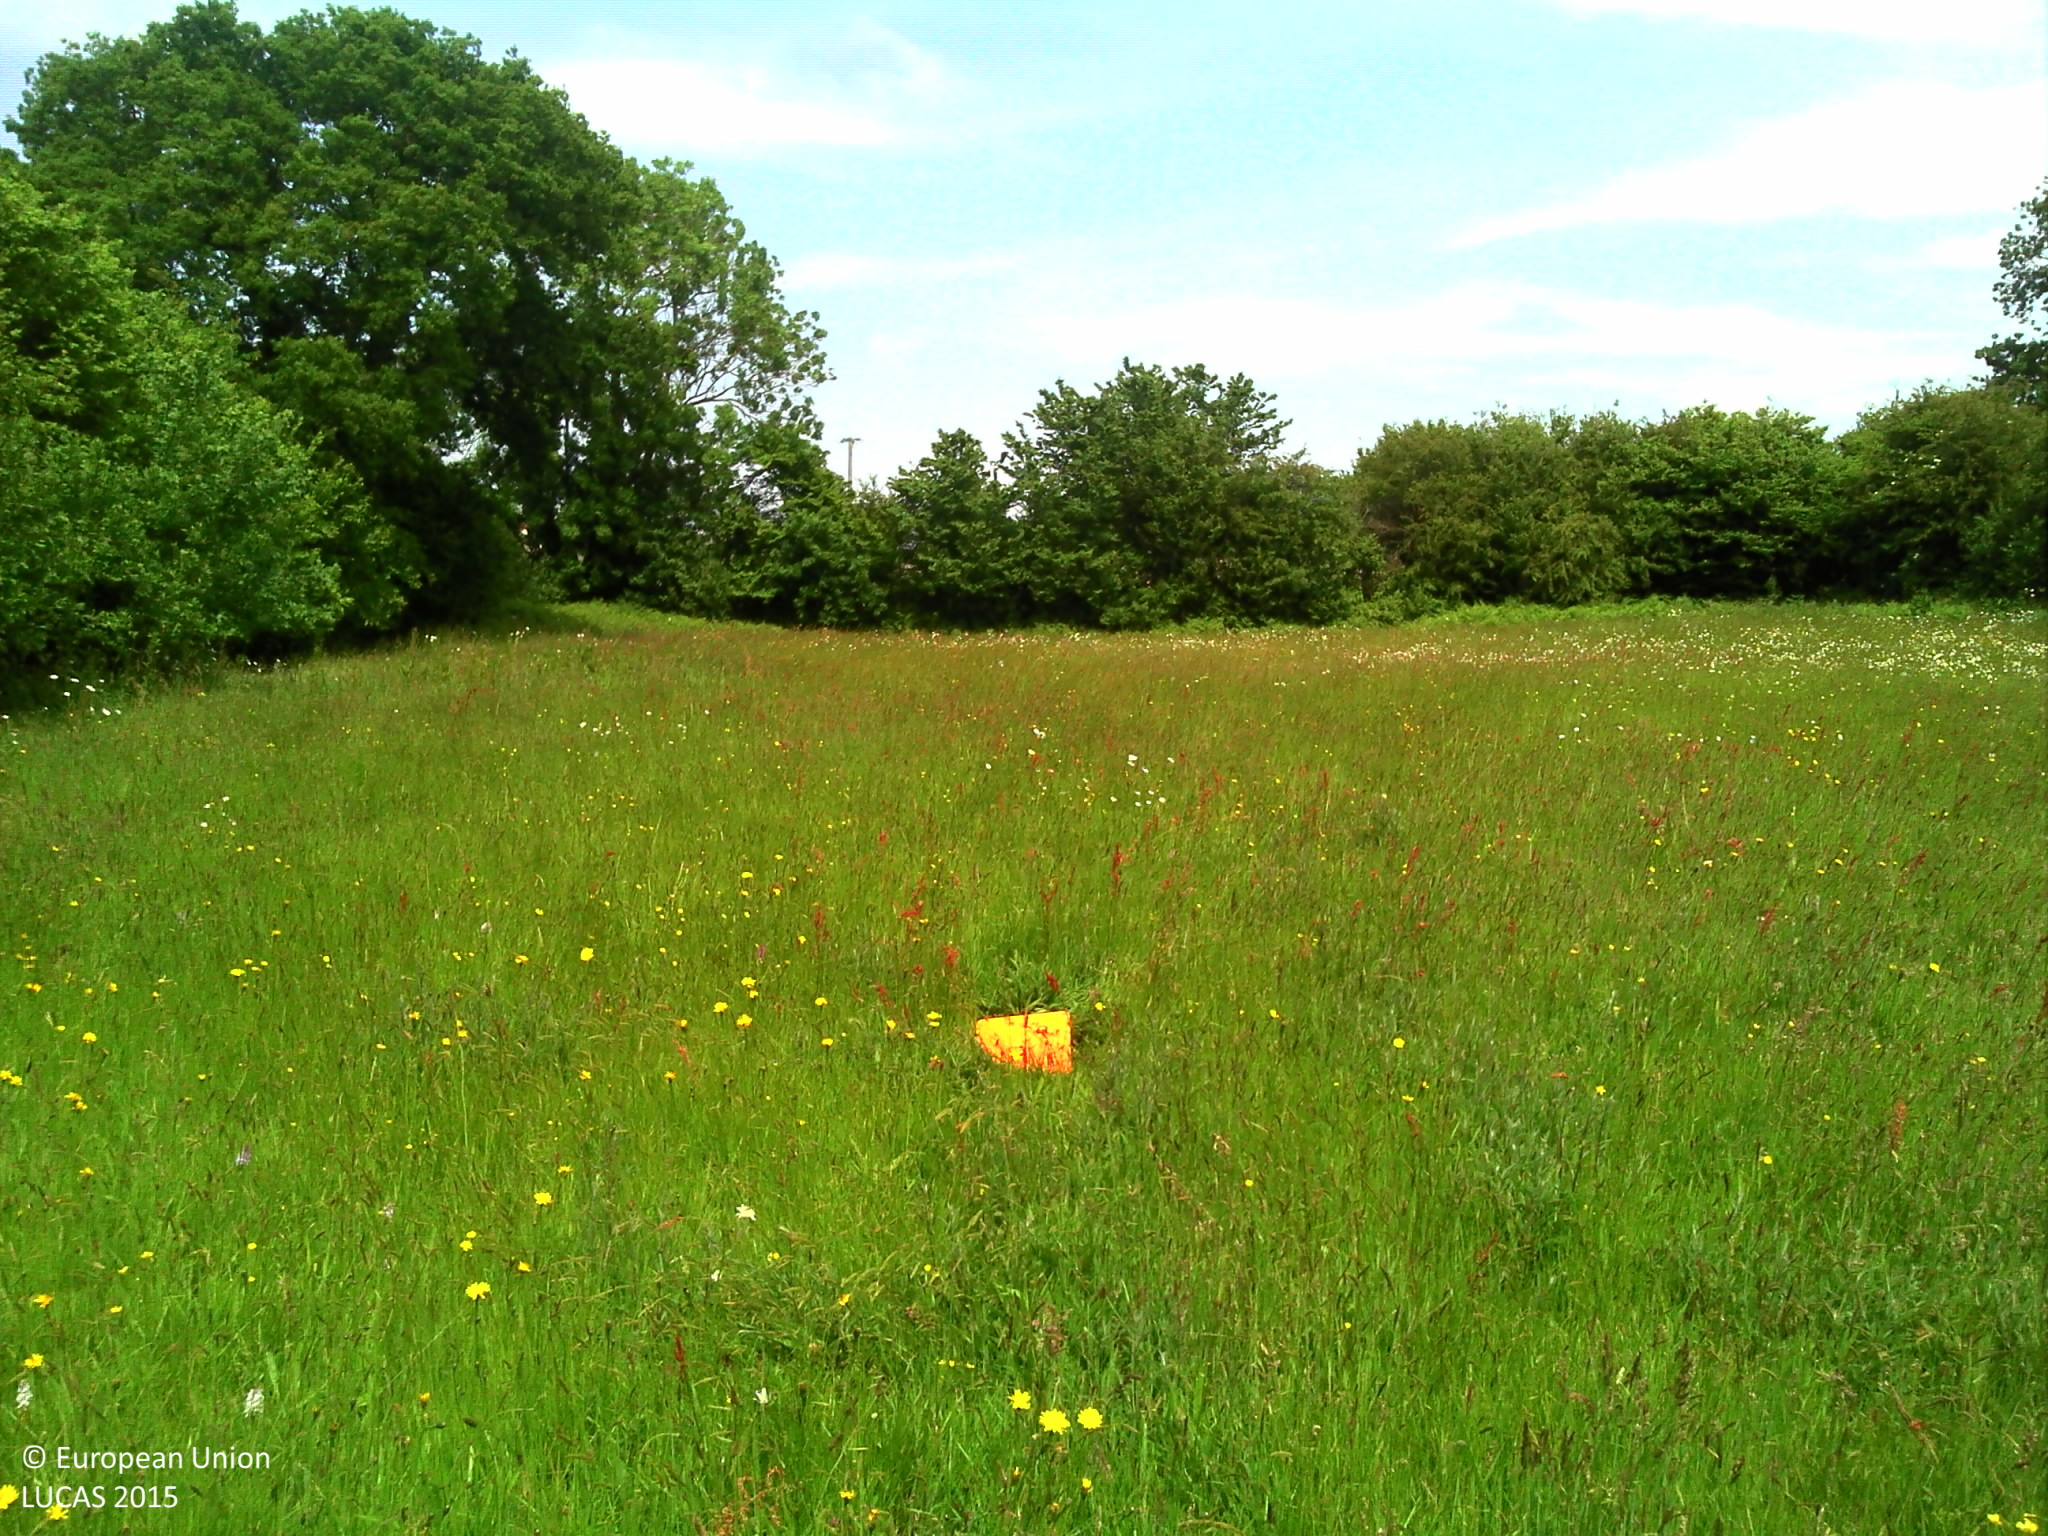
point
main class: Grassland
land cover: Grassland without tree/shrub cover
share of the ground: > 75 %
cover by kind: herbaceous plants 100 %
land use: Agriculture (excluding fallow land and kitchen gardens)
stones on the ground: < 10 %
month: June
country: FR
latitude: 49.4945
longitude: -1.4669
